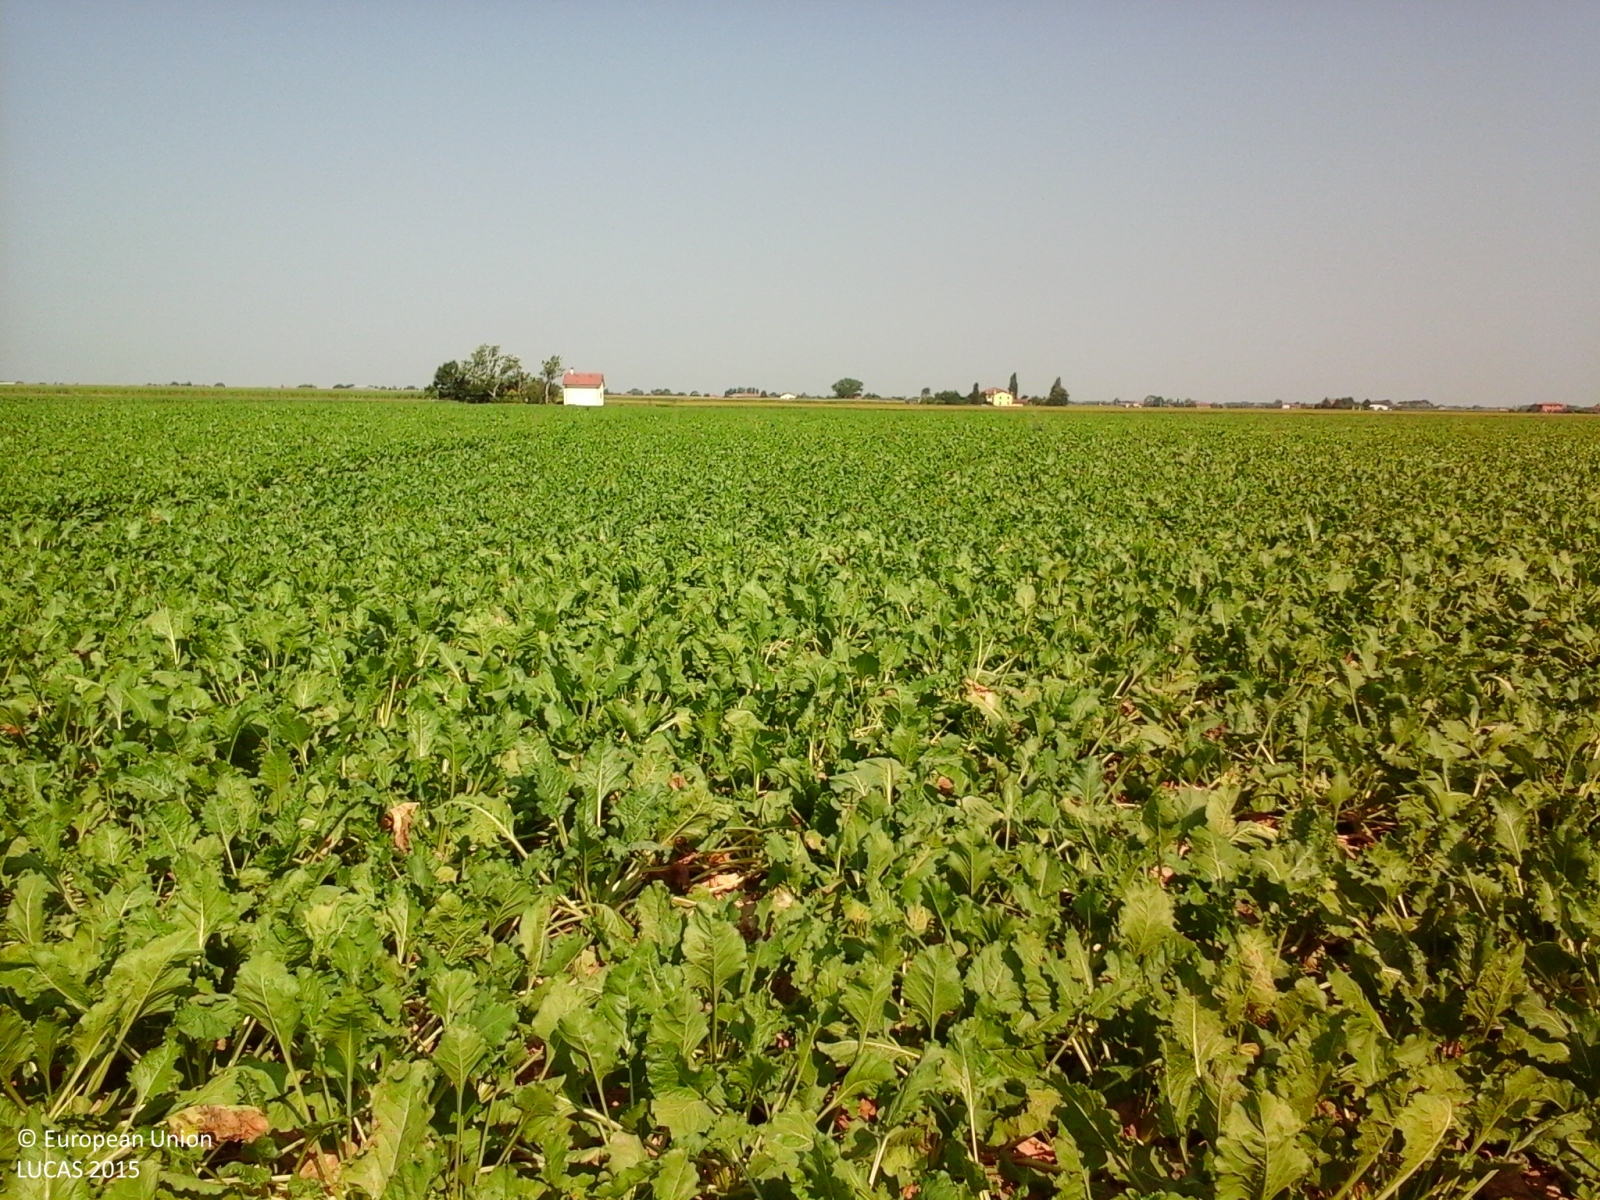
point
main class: Cropland
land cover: Sugar beet
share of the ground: > 75 %
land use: Agriculture (excluding fallow land and kitchen gardens)
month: July
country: IT
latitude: 44.4999
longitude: 11.6440
